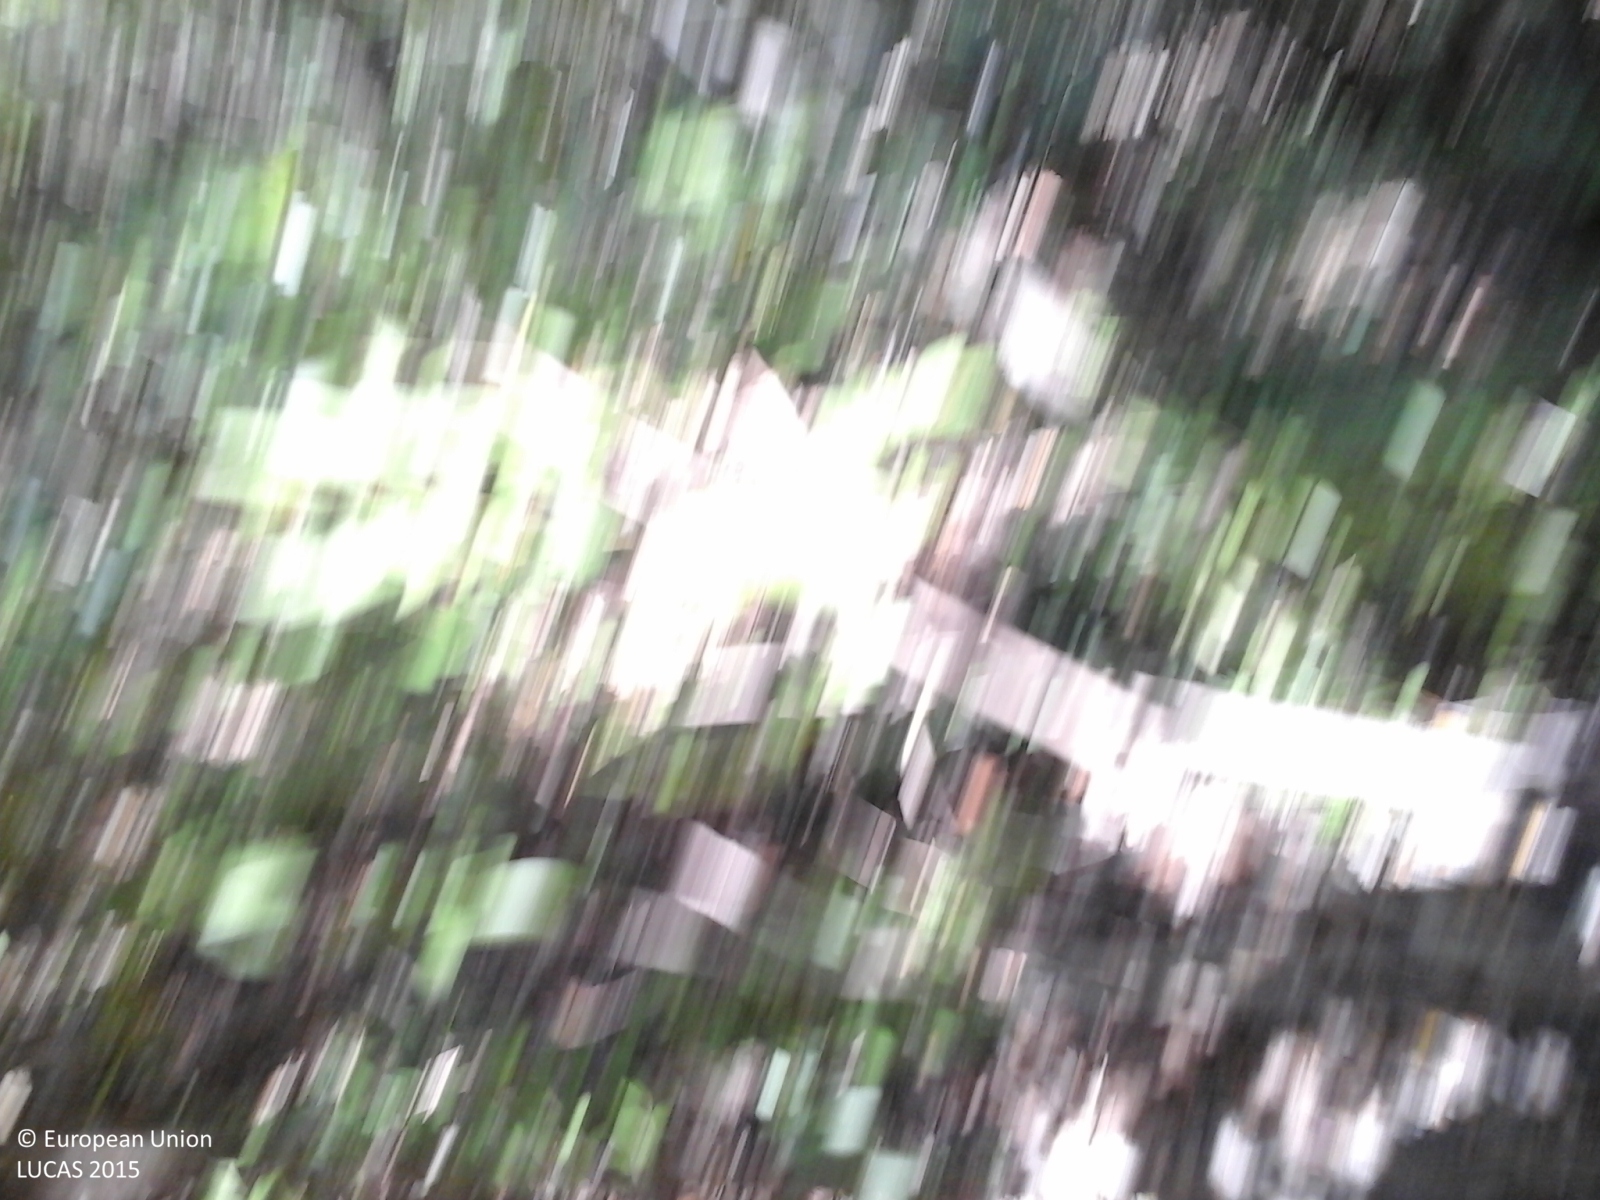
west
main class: Shrubland
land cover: Shrubland with sparse tree cover
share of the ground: > 75 %
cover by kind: shrubs 85 %, herbaceous plants 10 %, broadleaved forest trees 5 %
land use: Semi-natural and natural areas not in use
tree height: < 5 m
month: July
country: IT
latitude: 42.9672
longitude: 11.5522
